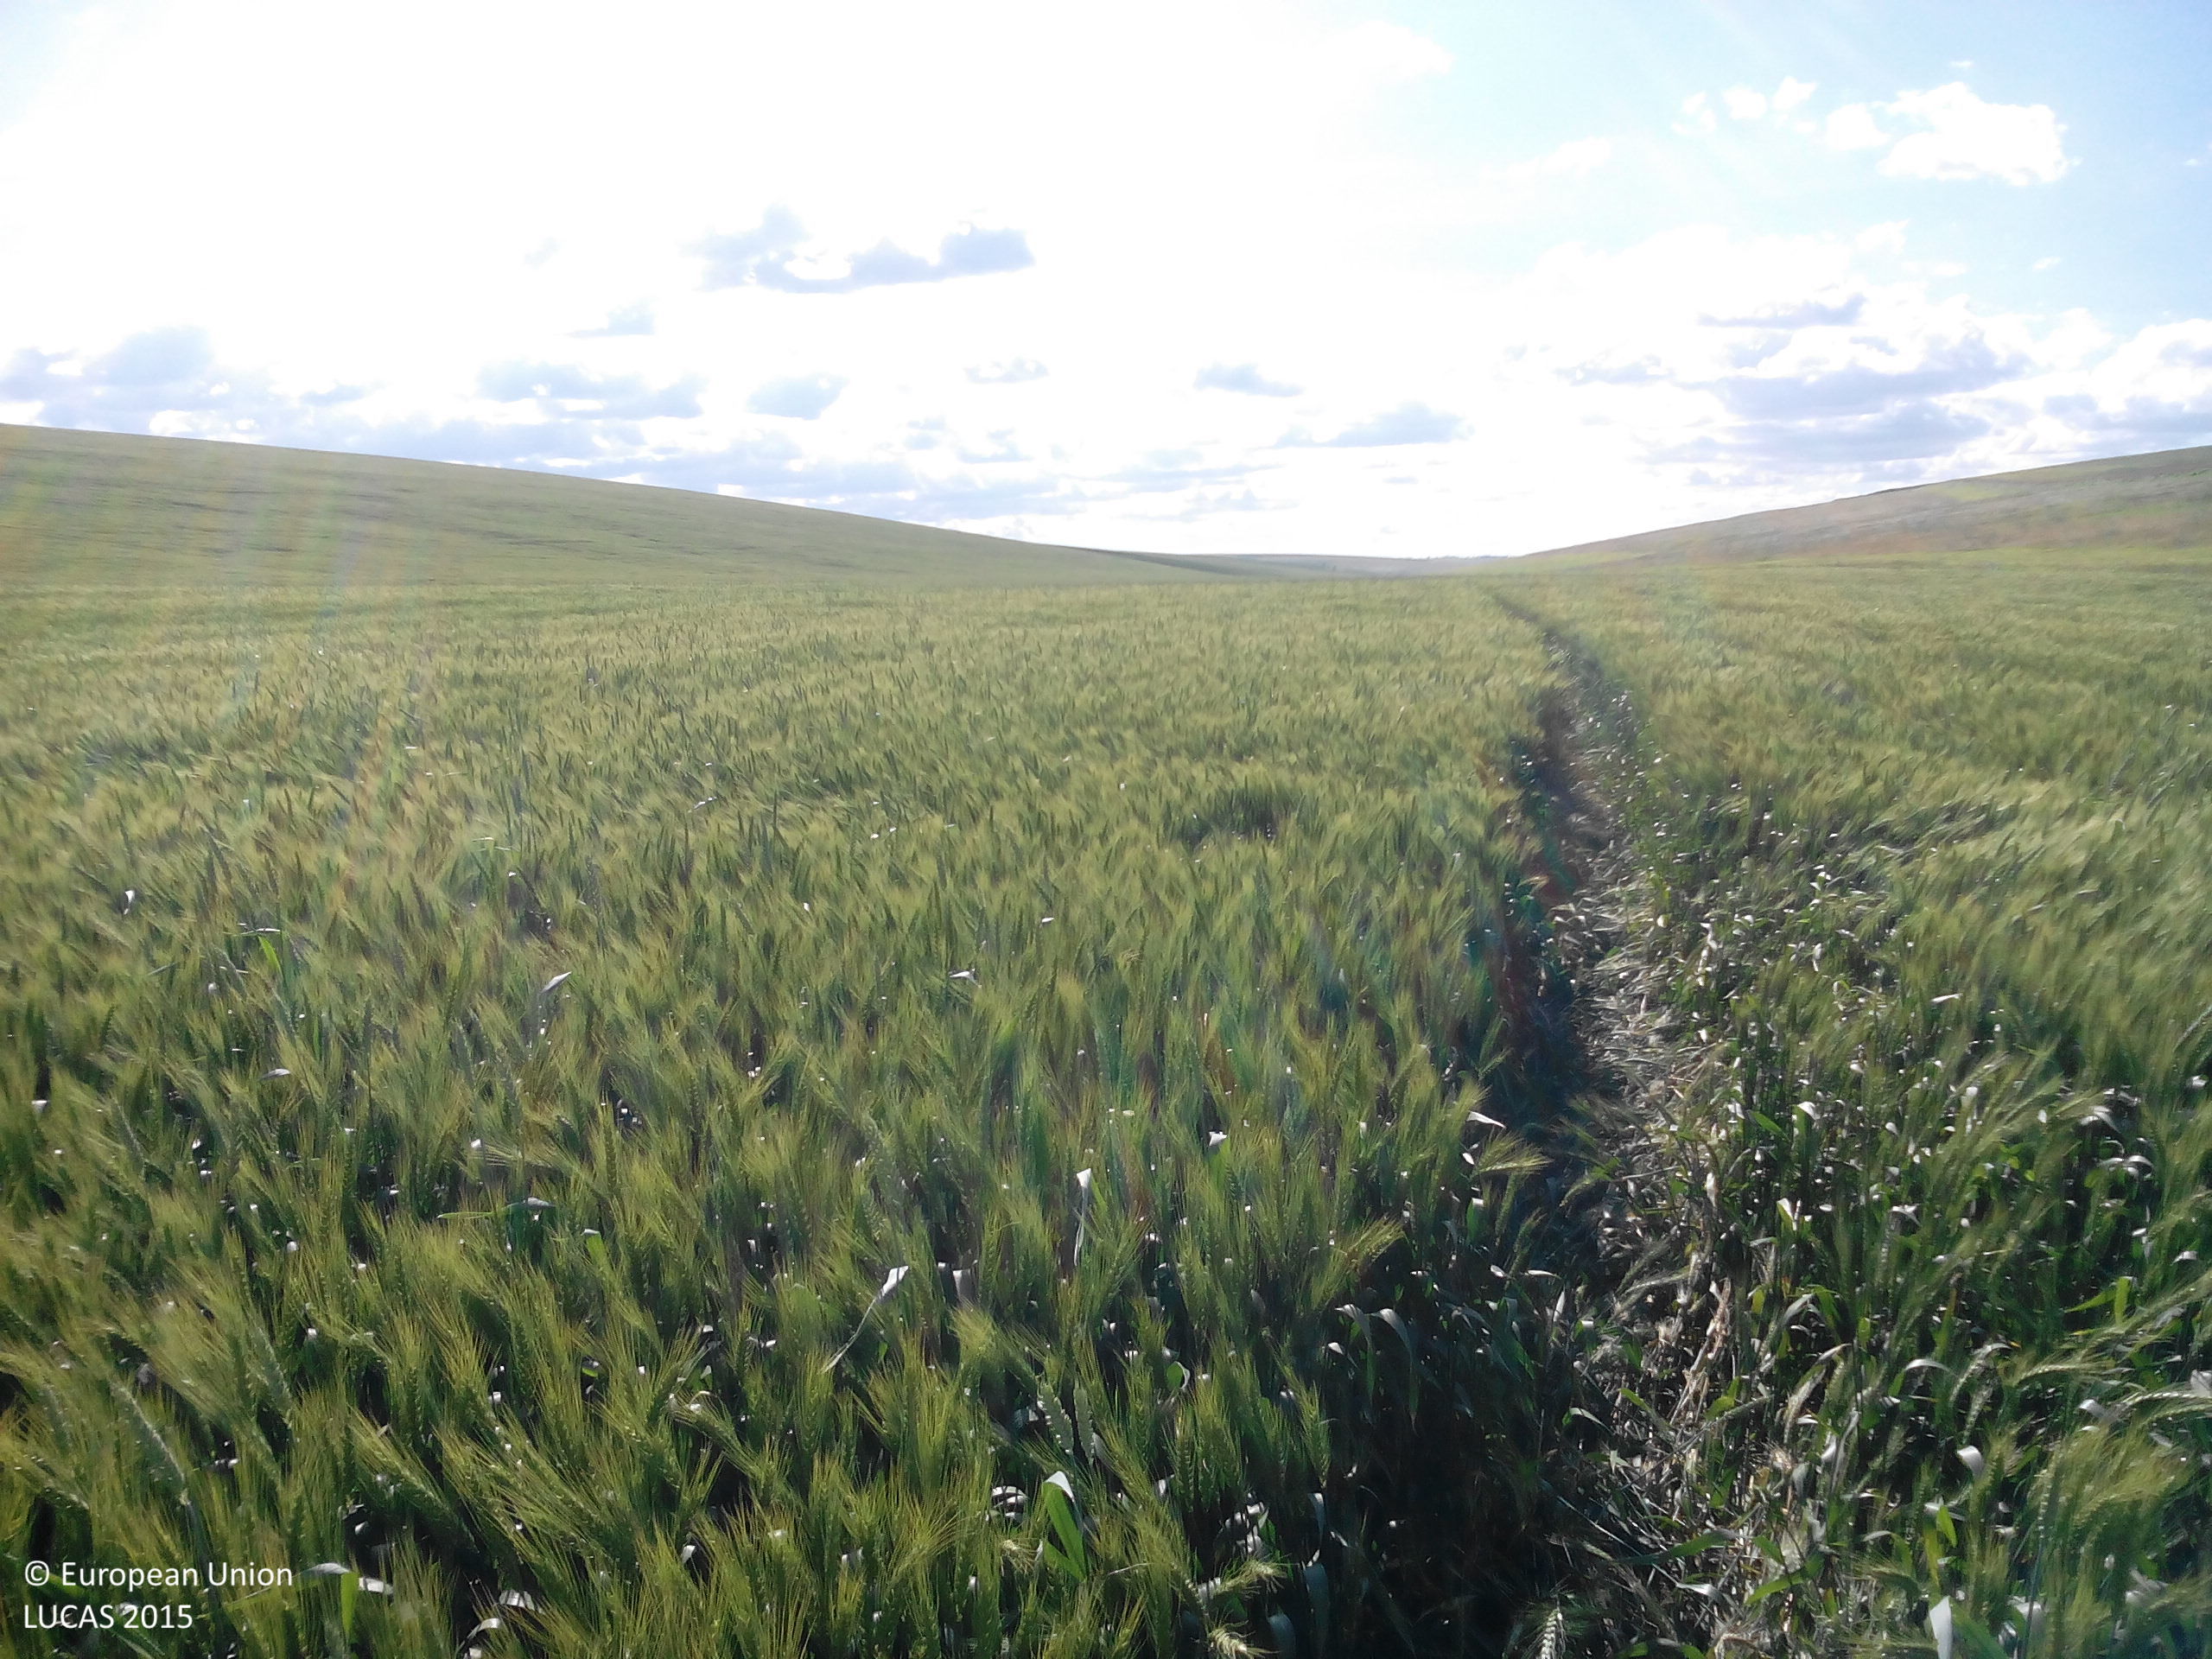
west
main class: Cropland
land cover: Rye
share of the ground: > 75 %
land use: Agriculture (excluding fallow land and kitchen gardens)
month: May
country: BG
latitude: 43.5607
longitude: 24.1316
